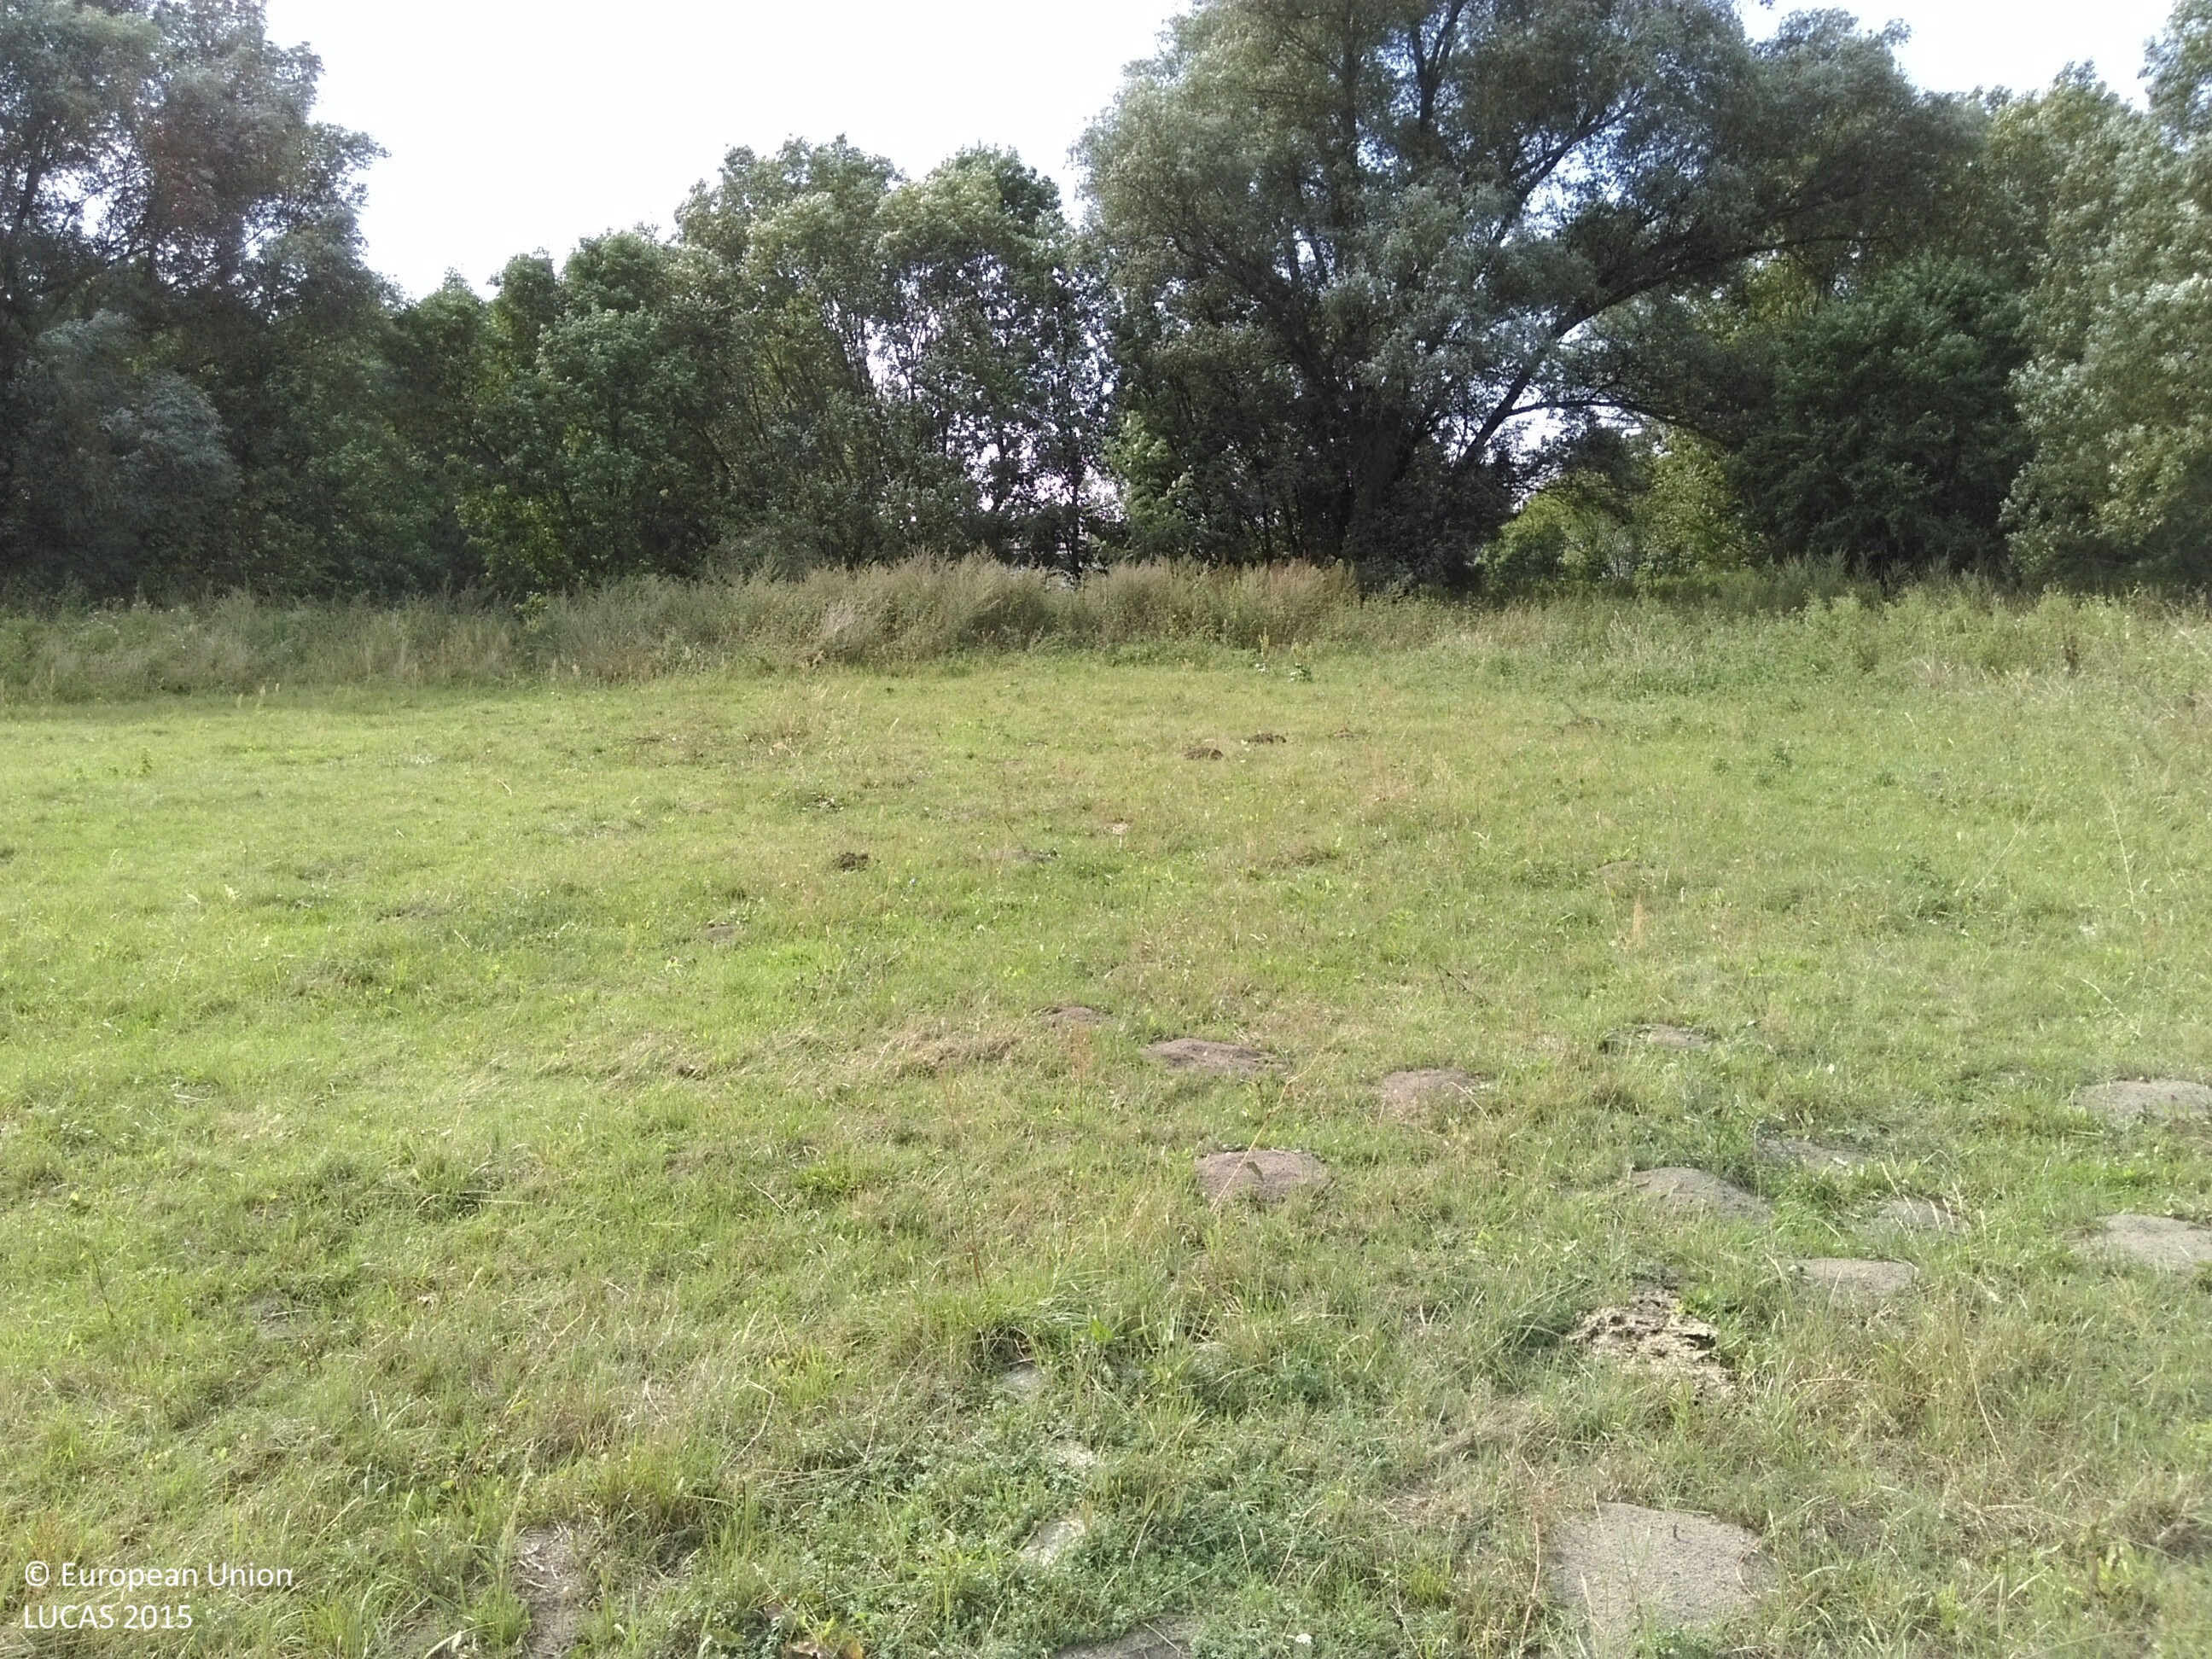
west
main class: Grassland
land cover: Grassland without tree/shrub cover
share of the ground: > 75 %
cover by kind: herbaceous plants 100 %
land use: Agriculture (excluding fallow land and kitchen gardens)
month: September
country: PL
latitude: 51.8864
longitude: 15.5689
